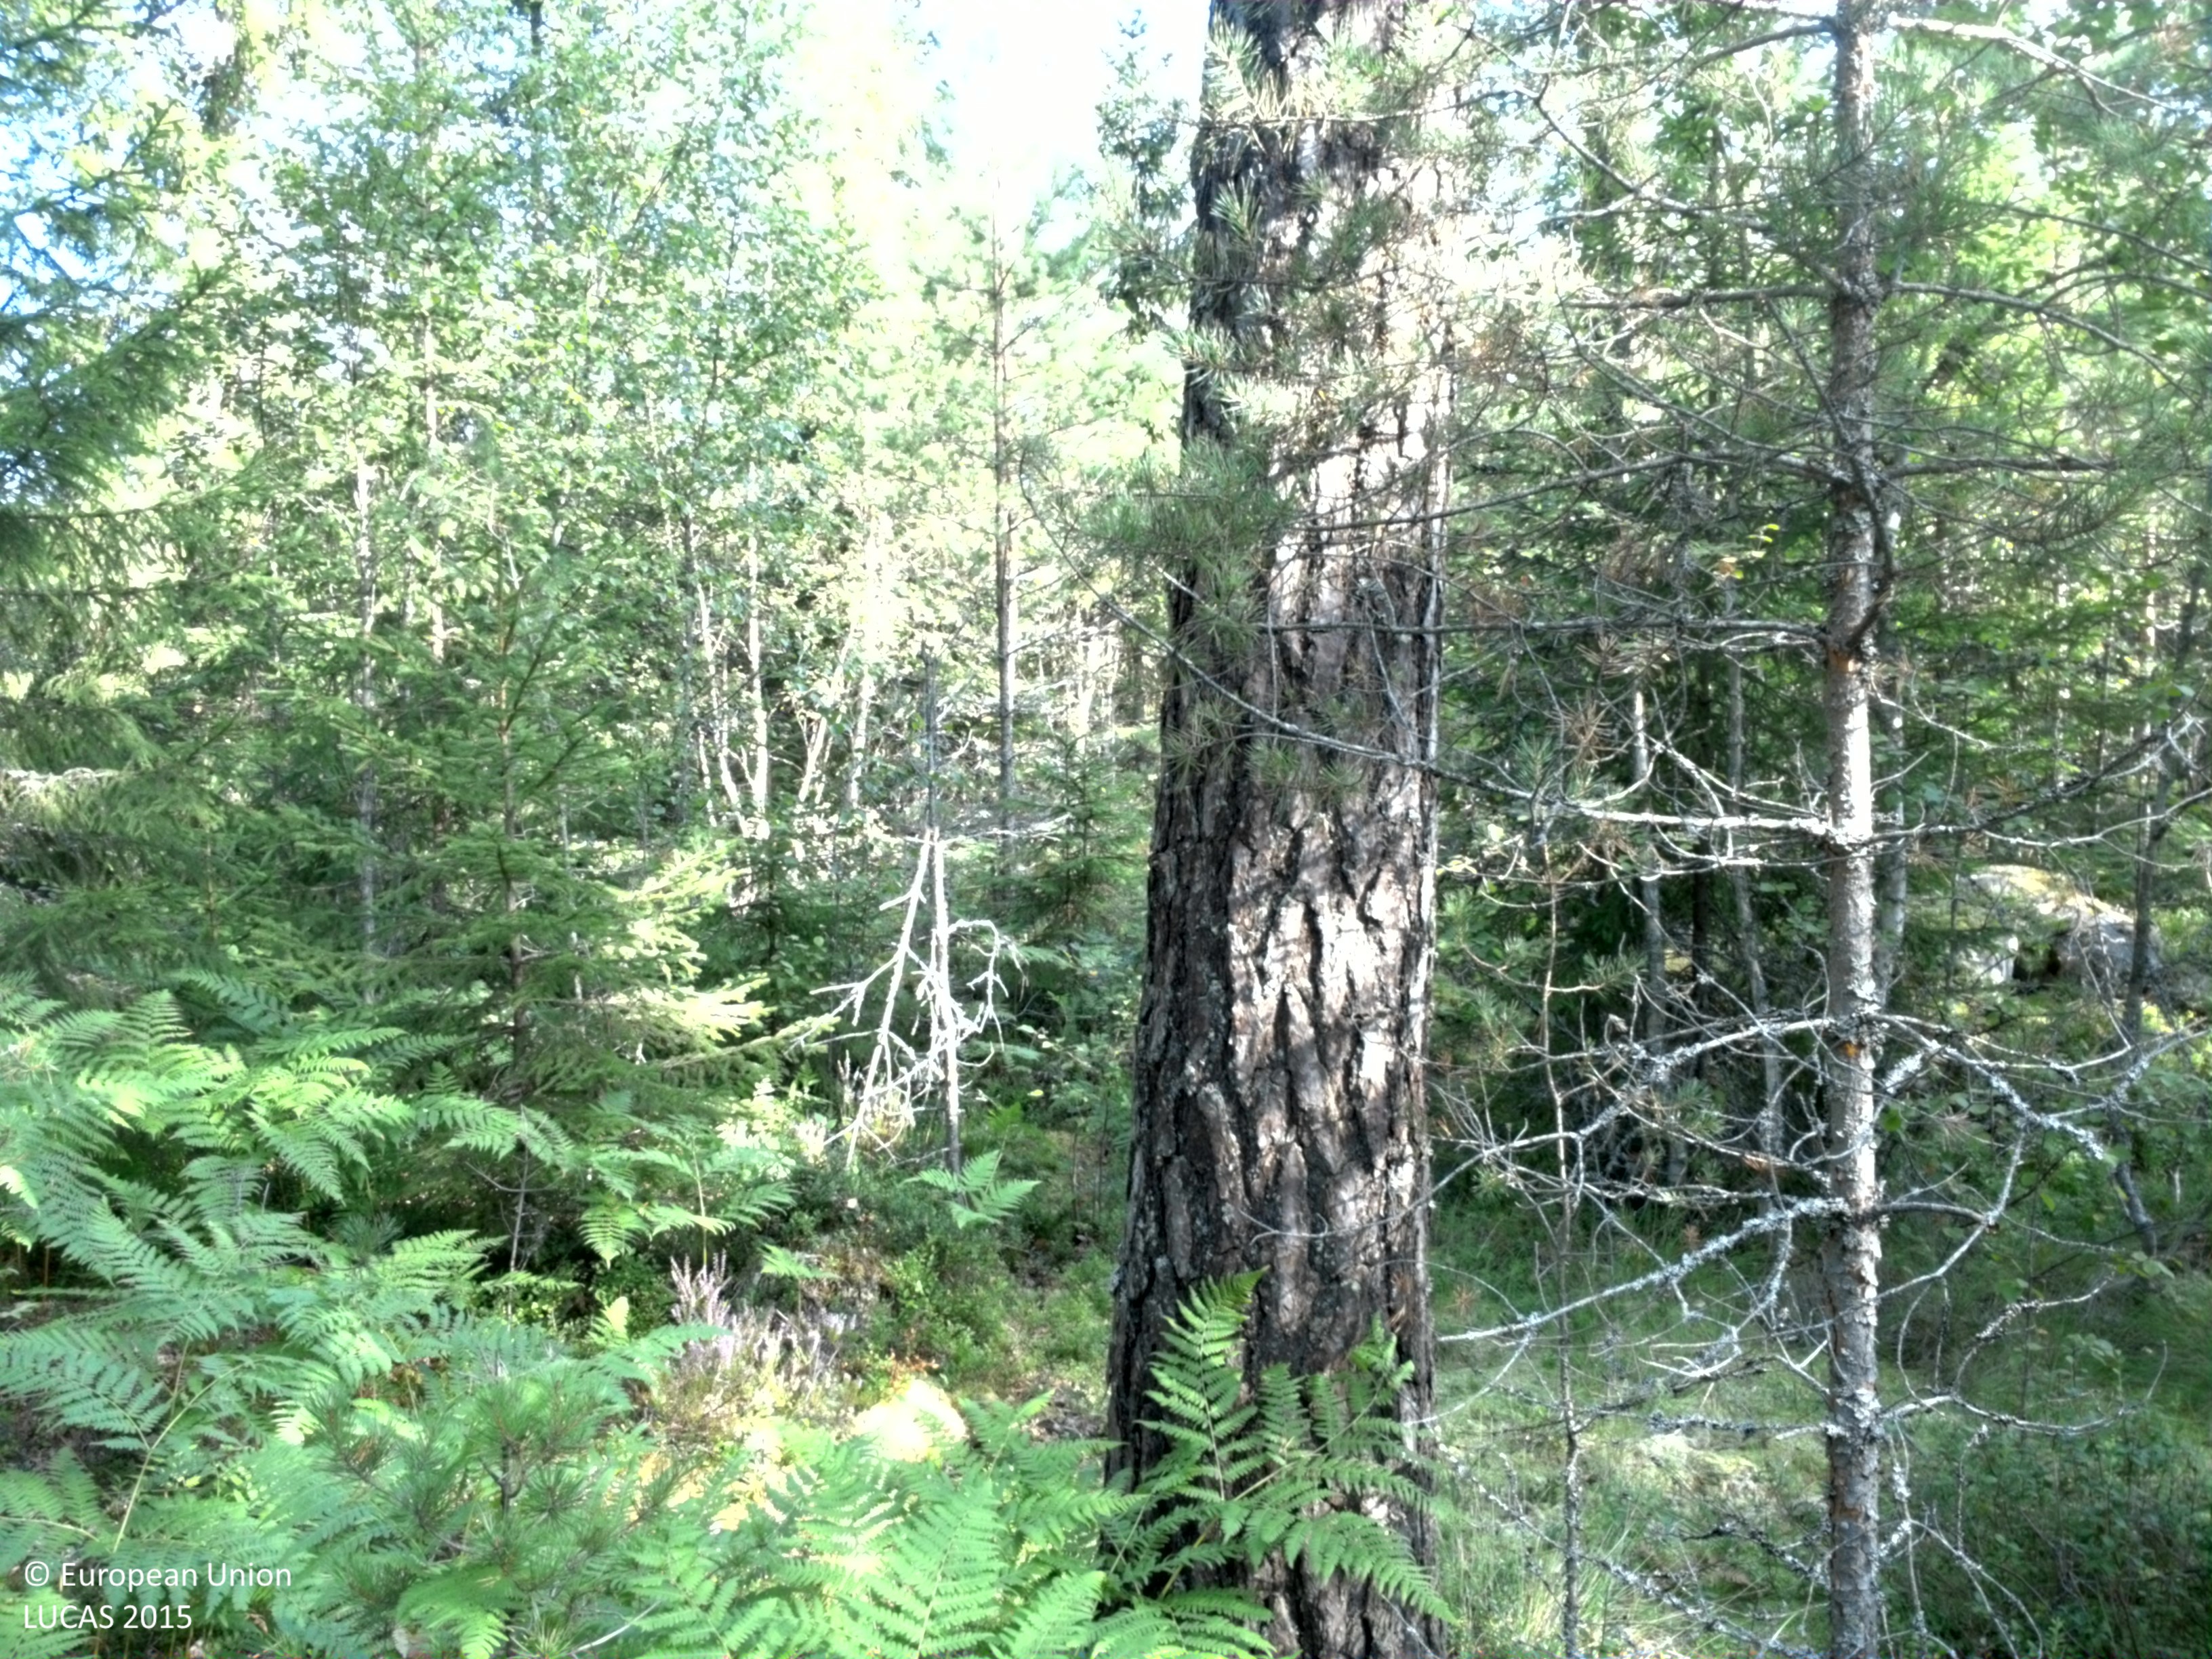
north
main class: Woodland
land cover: Pine dominated coniferous woodland
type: boreal forest
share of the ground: 50 - 75 %
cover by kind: coniferous forest trees 60 %, lichens and mosses 25 %, broadleaved forest trees 15 %
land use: Forestry
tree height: > 5 m
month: August
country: SE
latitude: 60.0190
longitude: 17.7984
